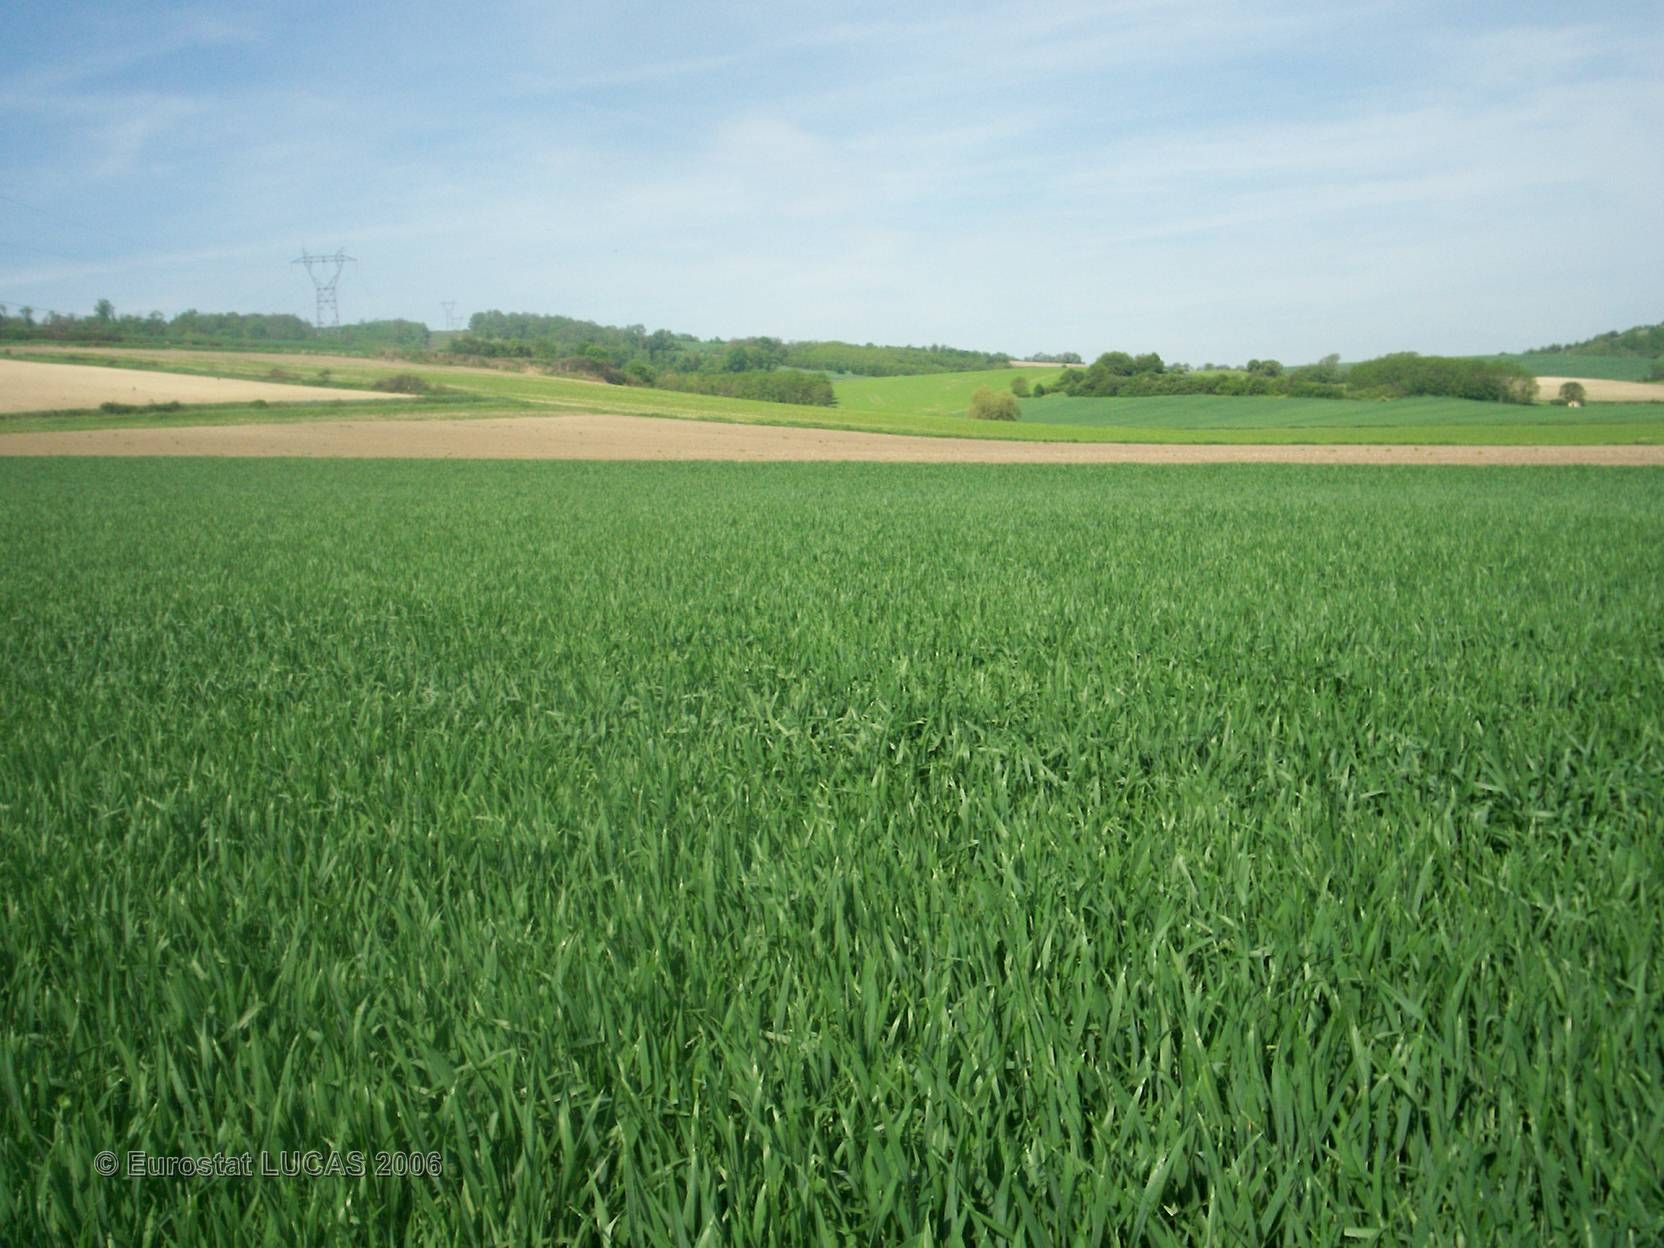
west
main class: Cropland
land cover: Common wheat
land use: Agriculture (excluding fallow land and kitchen gardens)
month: May
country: FR
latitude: 45.5382
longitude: 3.2007
